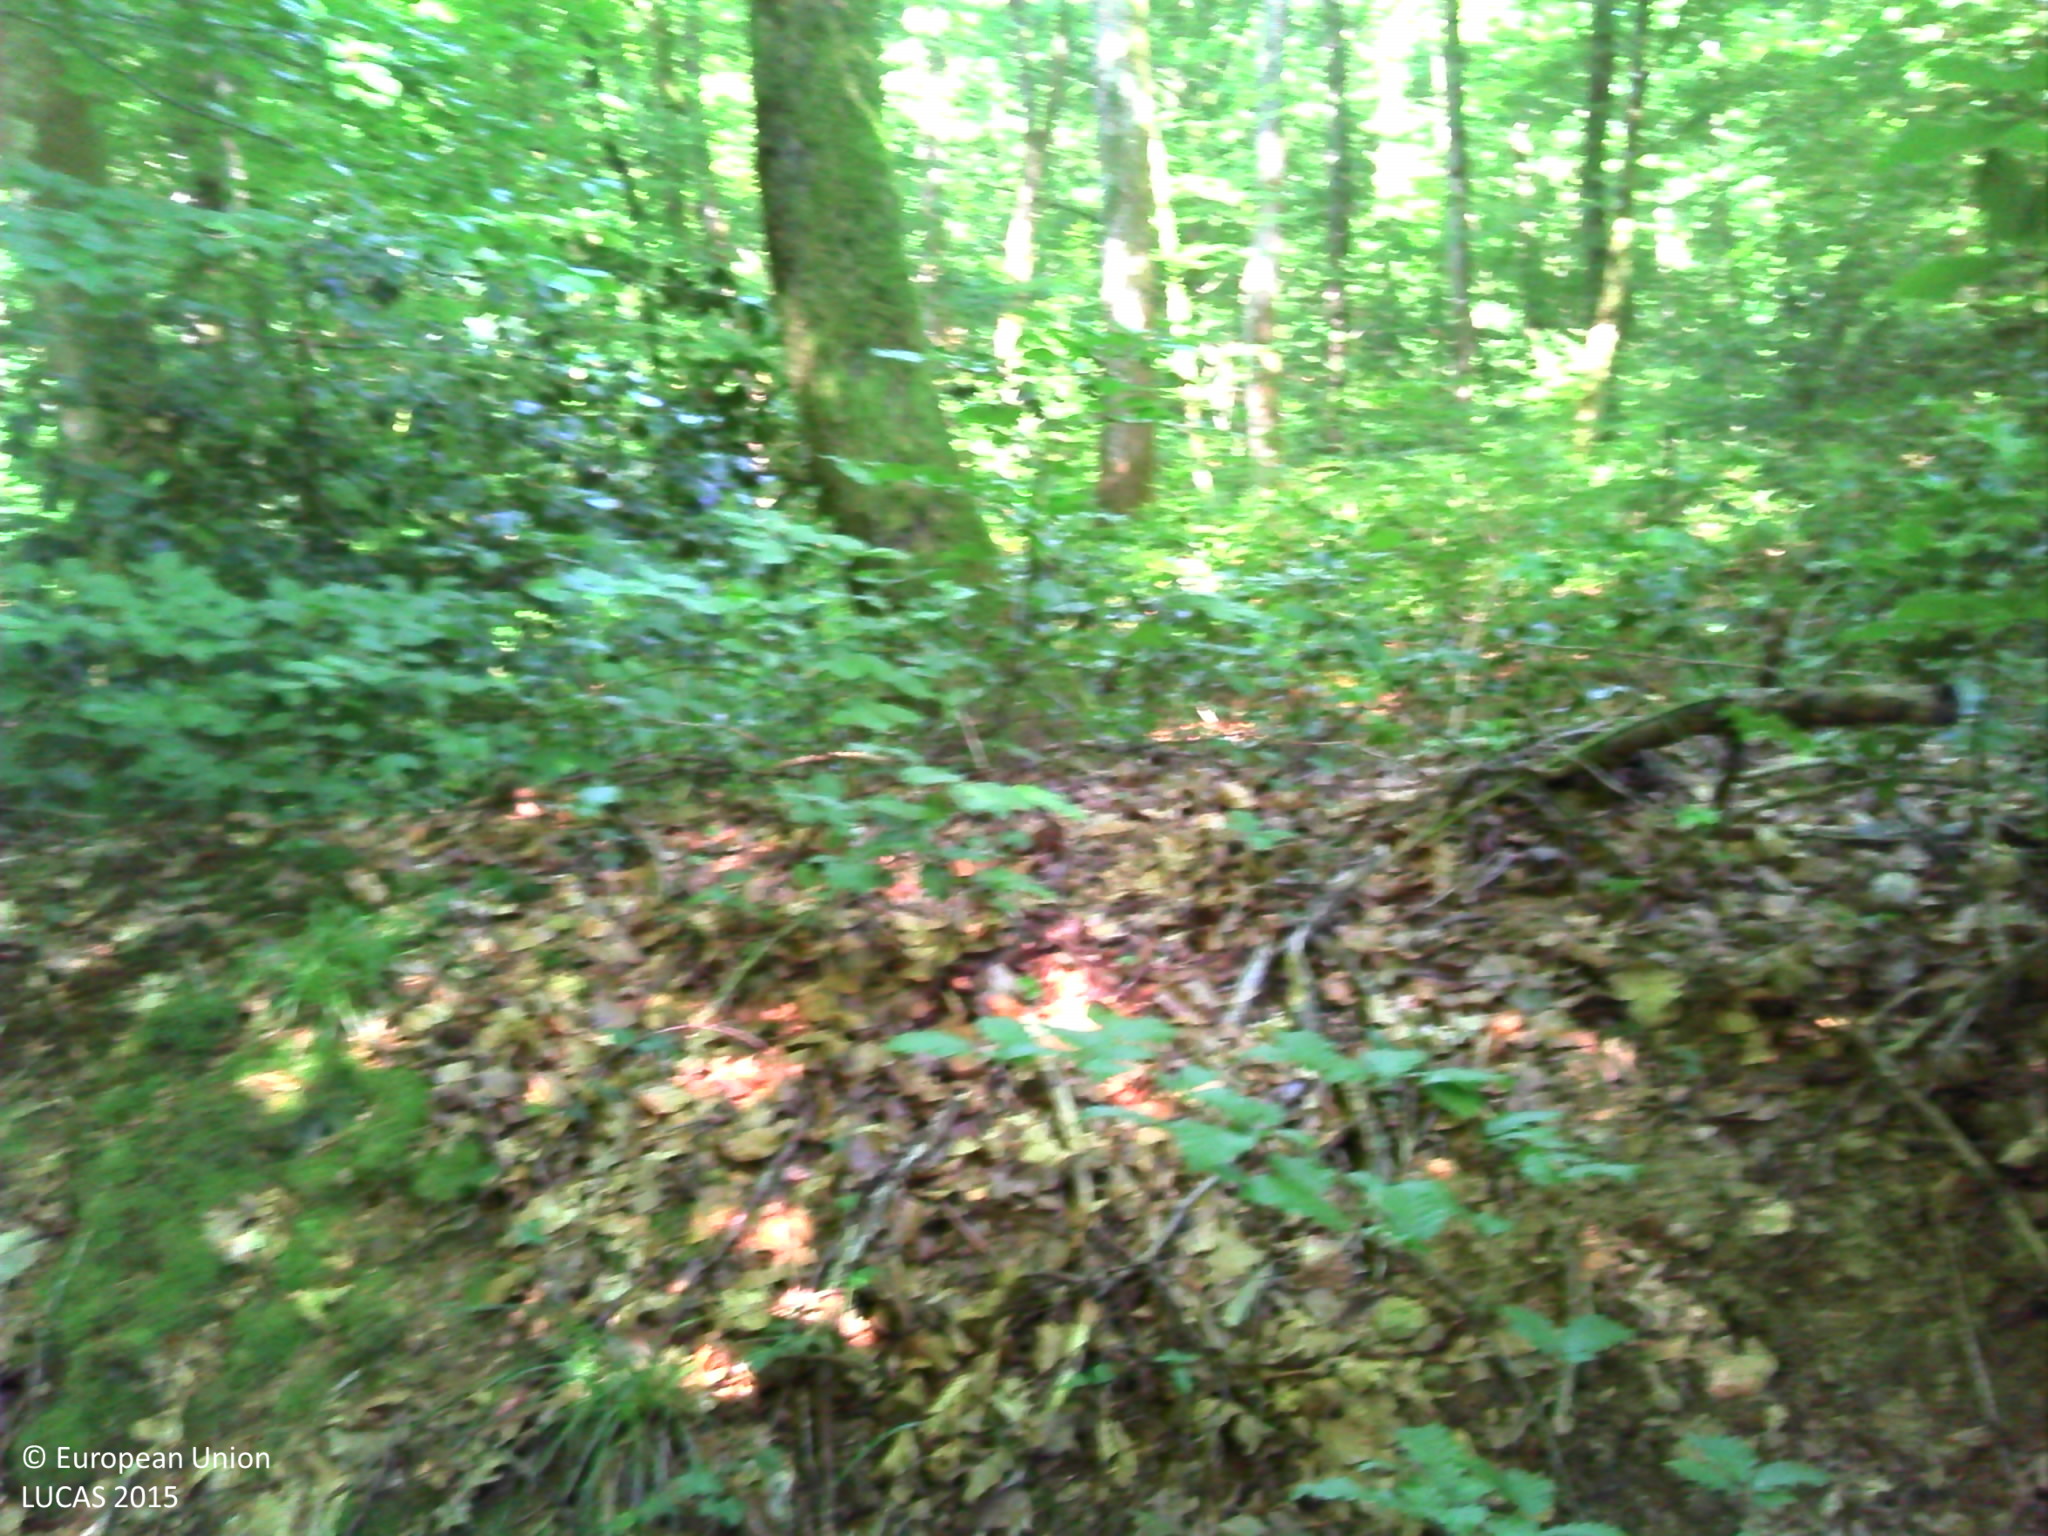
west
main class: Woodland
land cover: Broadleaved woodland
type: beech forest
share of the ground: > 75 %
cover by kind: broadleaved forest trees 95 %, herbaceous plants 5 %
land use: Forestry
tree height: > 5 m
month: June
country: FR
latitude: 47.4174
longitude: 6.1445
